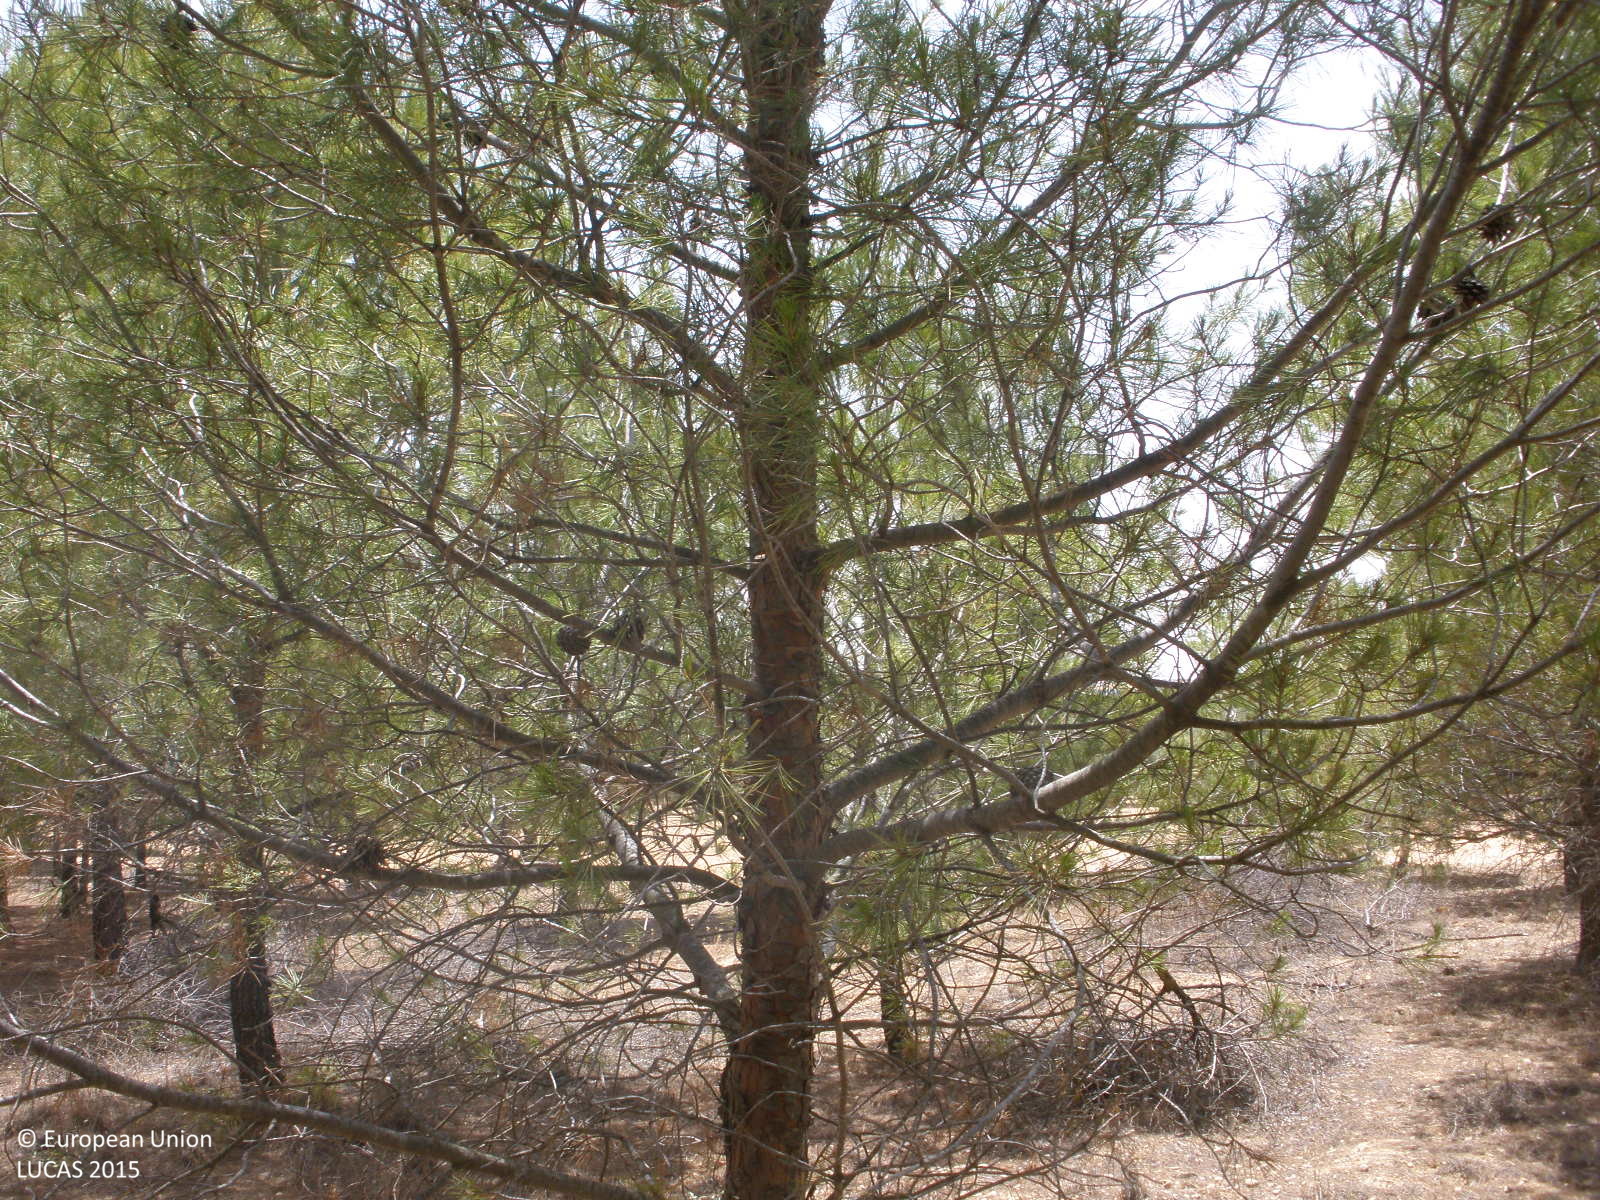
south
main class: Woodland
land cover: Pine dominated coniferous woodland
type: coniferous forest of the mediterranean region
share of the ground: 50 - 75 %
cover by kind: coniferous forest trees 70 %, herbaceous plants 20 %, consolidated bare surface 10 %
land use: Forestry
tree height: > 5 m
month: July
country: ES
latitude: 39.8194
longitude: -3.4024
